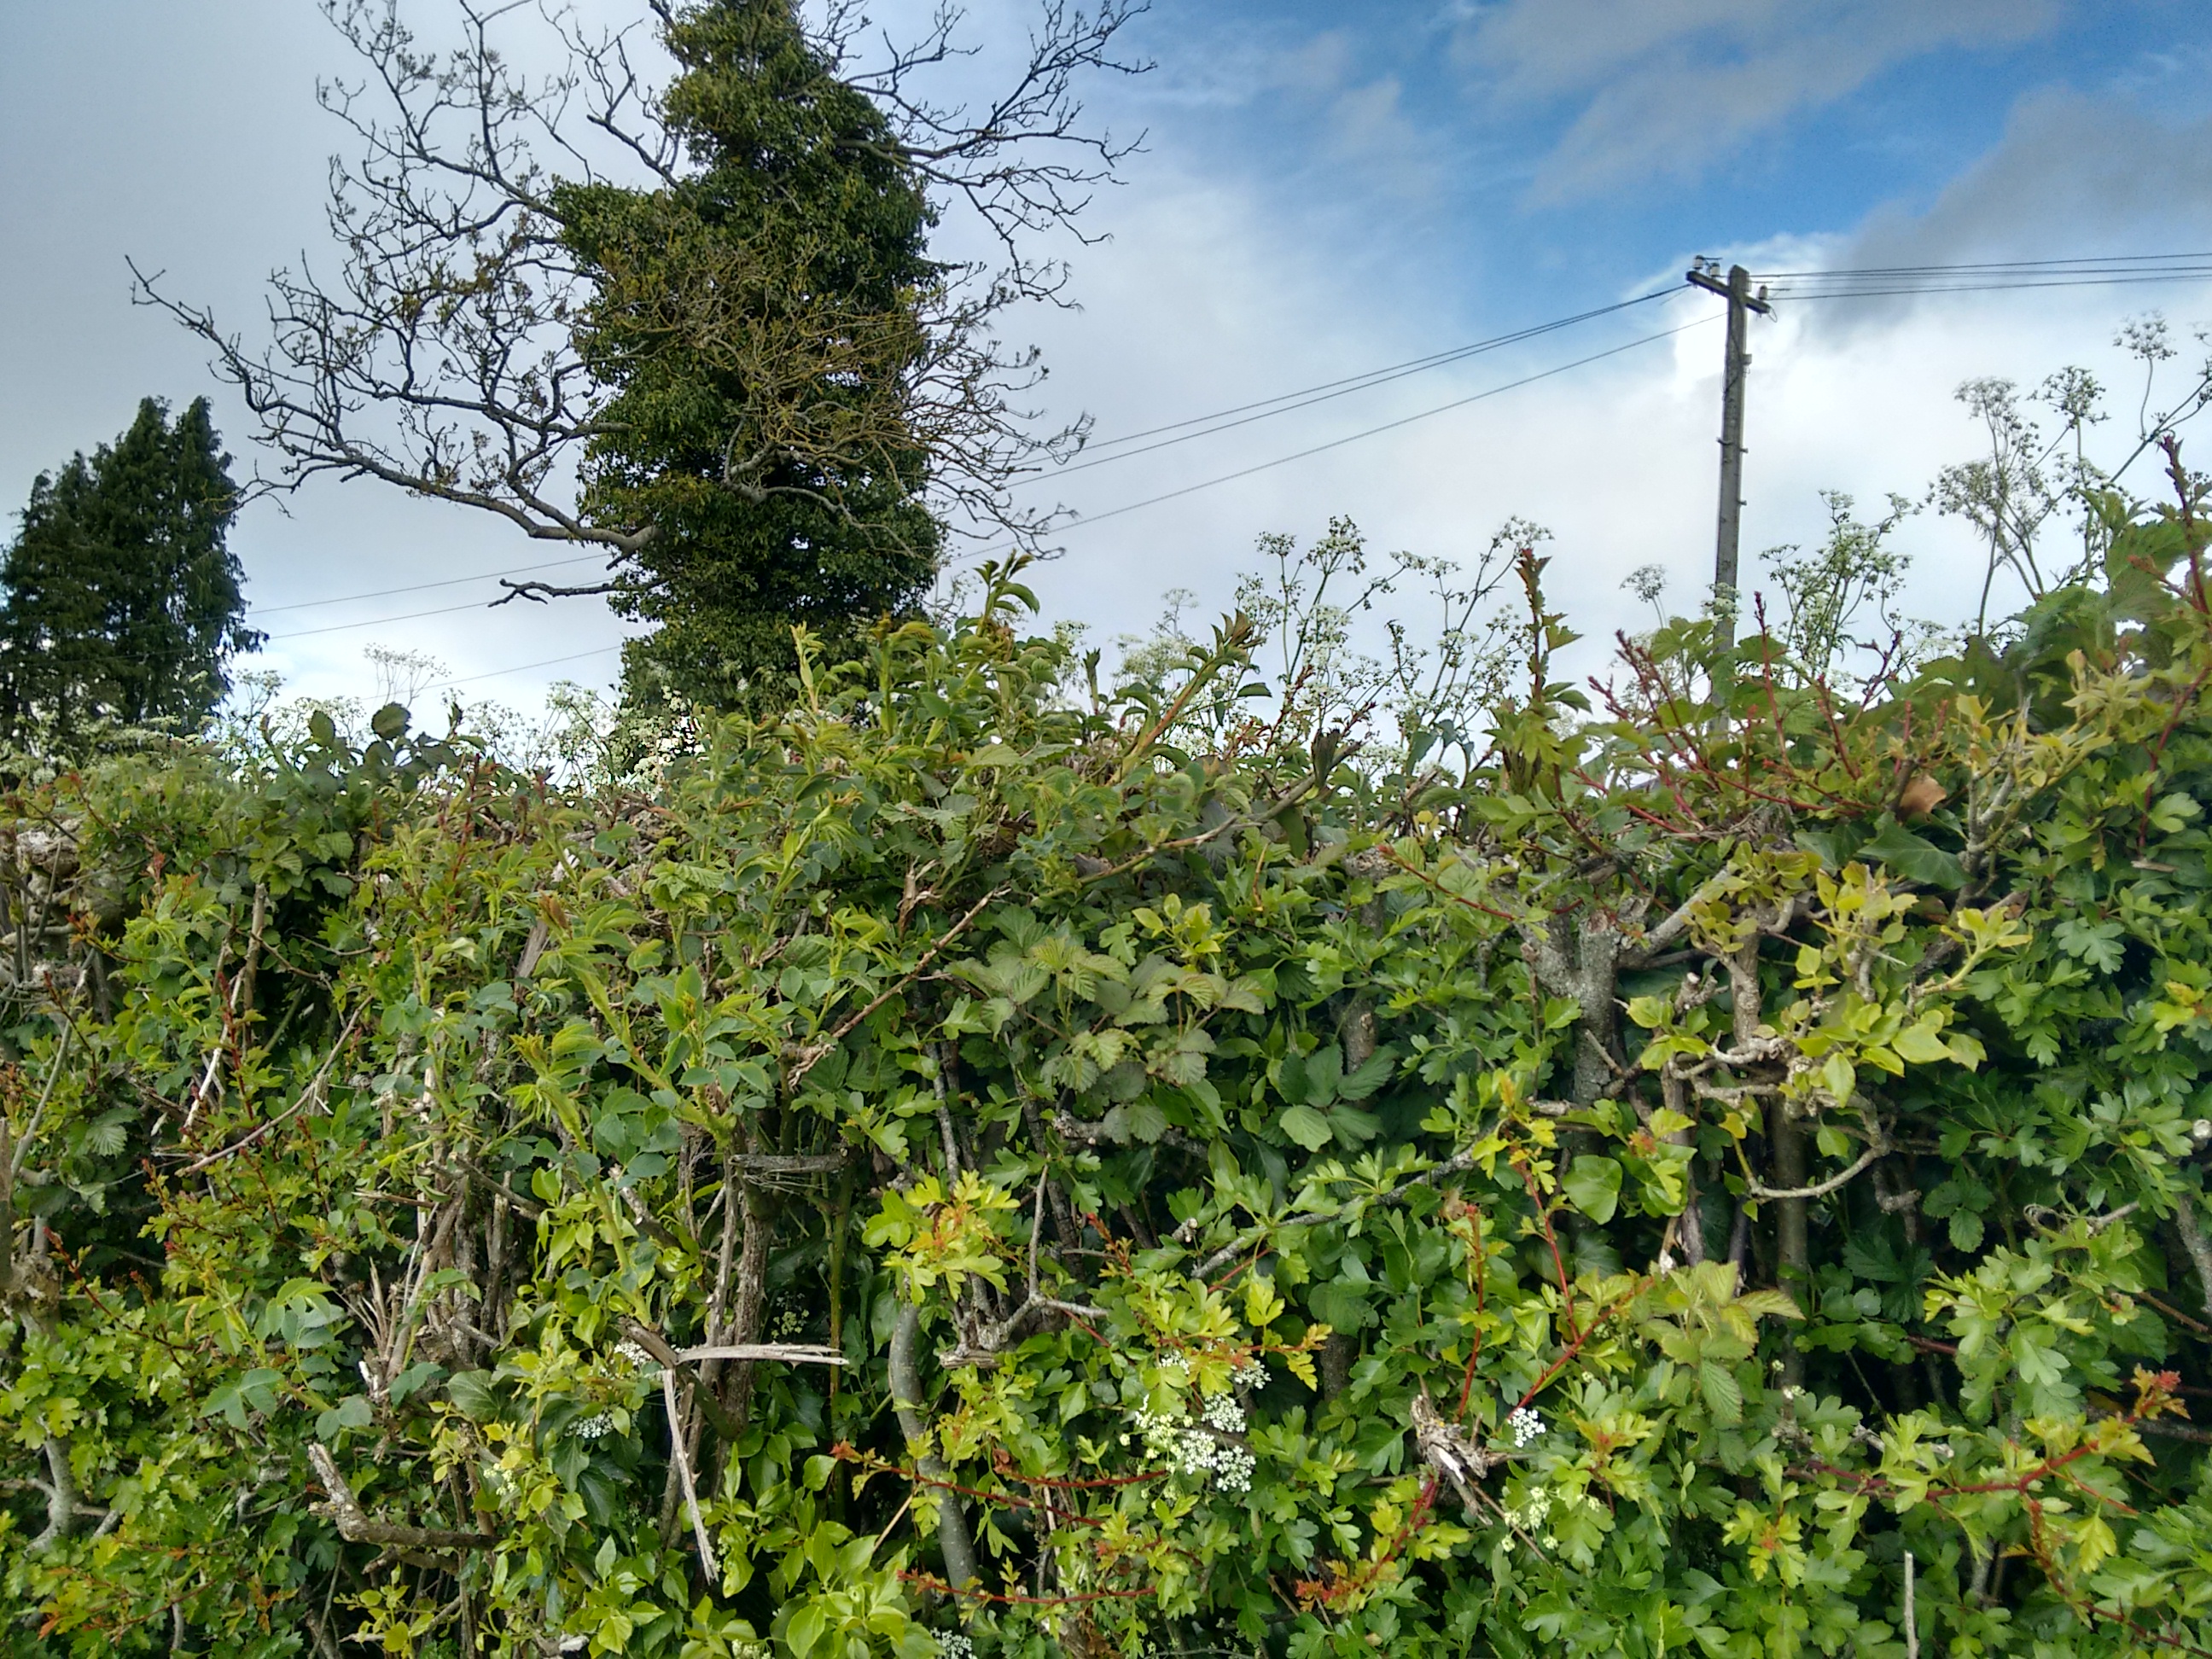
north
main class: Cropland
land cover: Barley
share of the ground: 50 - 75 %
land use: Agriculture (excluding fallow land and kitchen gardens)
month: May
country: IE
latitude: 53.3421
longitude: -6.6376
